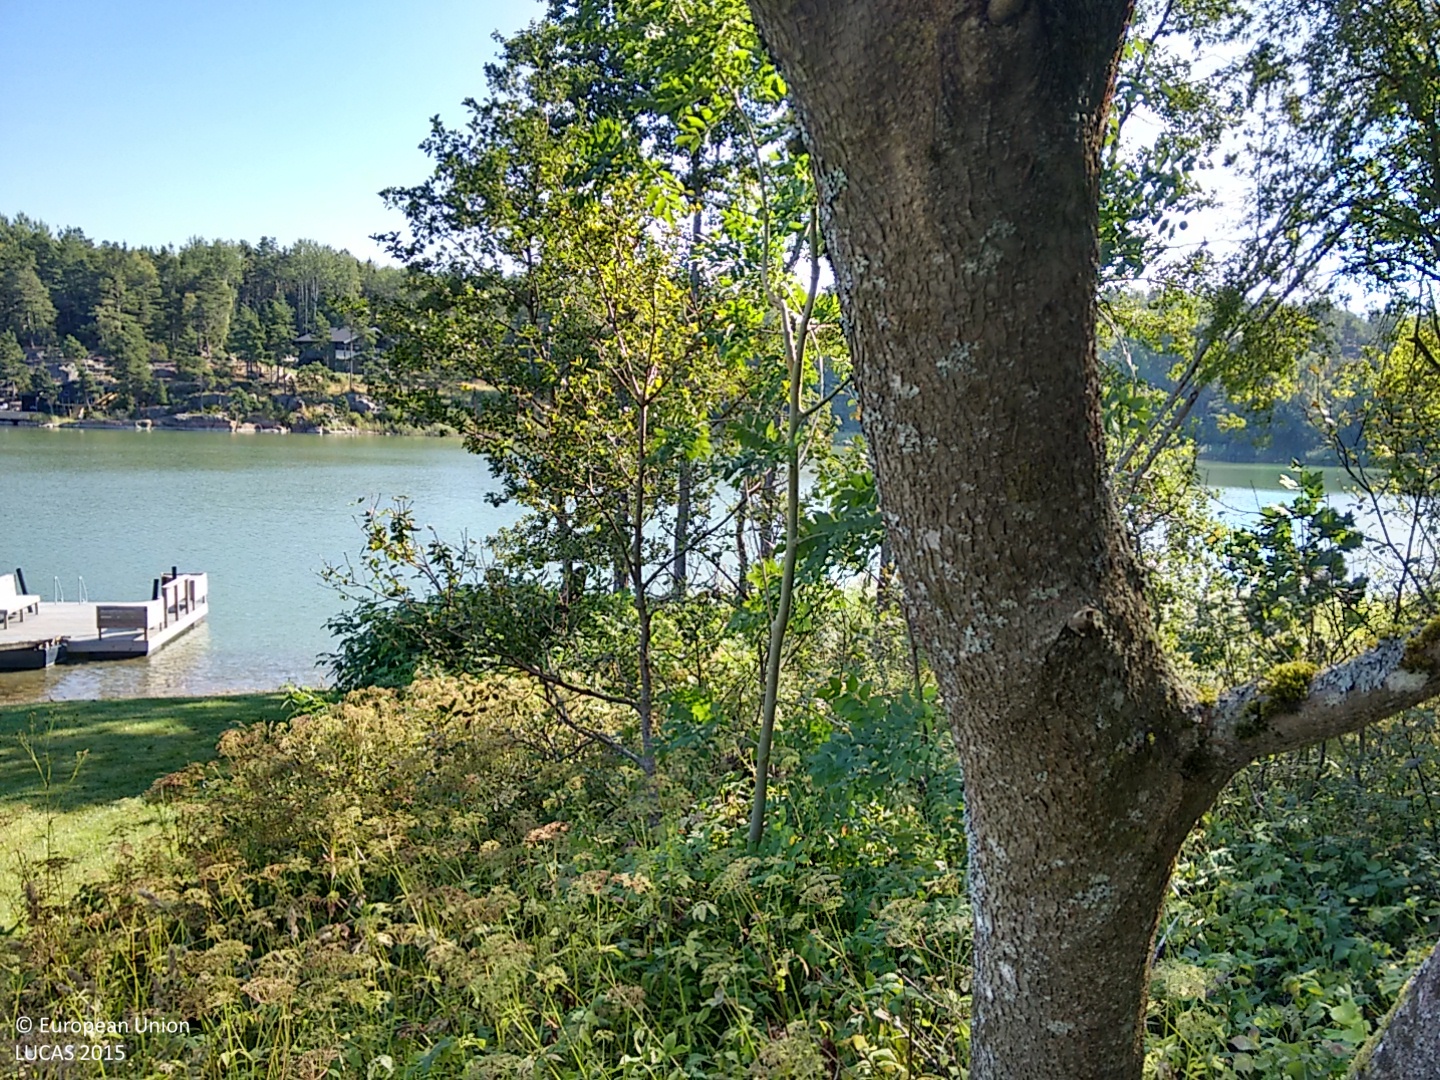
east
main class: Woodland
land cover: Broadleaved woodland
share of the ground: 50 - 75 %
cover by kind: broadleaved forest trees 70 %, herbaceous plants 30 %
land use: Residential
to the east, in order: Broadleaved woodland; Salt marshes; Transitional water bodies; Spruce dominated mixed woodland
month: August
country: FI
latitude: 60.2402
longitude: 20.0309
